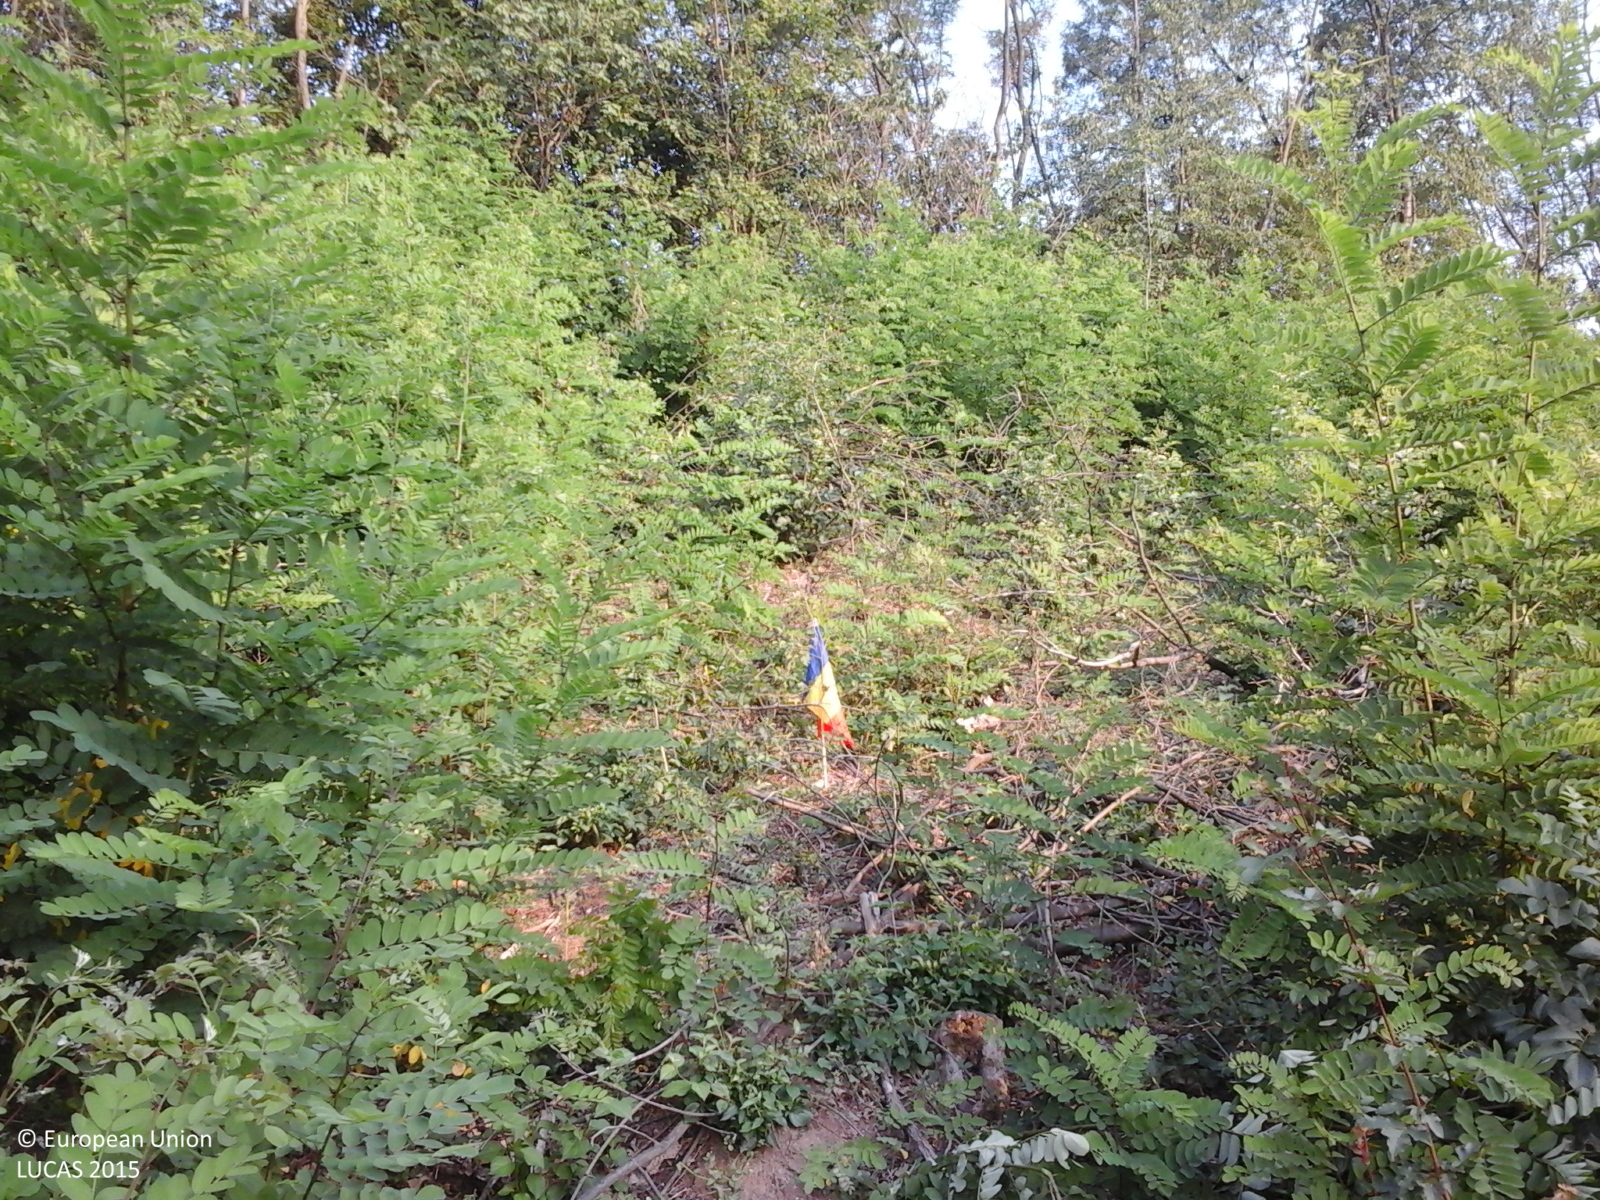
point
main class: Shrubland
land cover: Shrubland with sparse tree cover
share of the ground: > 75 %
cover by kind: shrubs 95 %, broadleaved forest trees 5 %
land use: Forestry
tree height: < 5 m
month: July
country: RO
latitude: 44.8644
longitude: 24.4893
